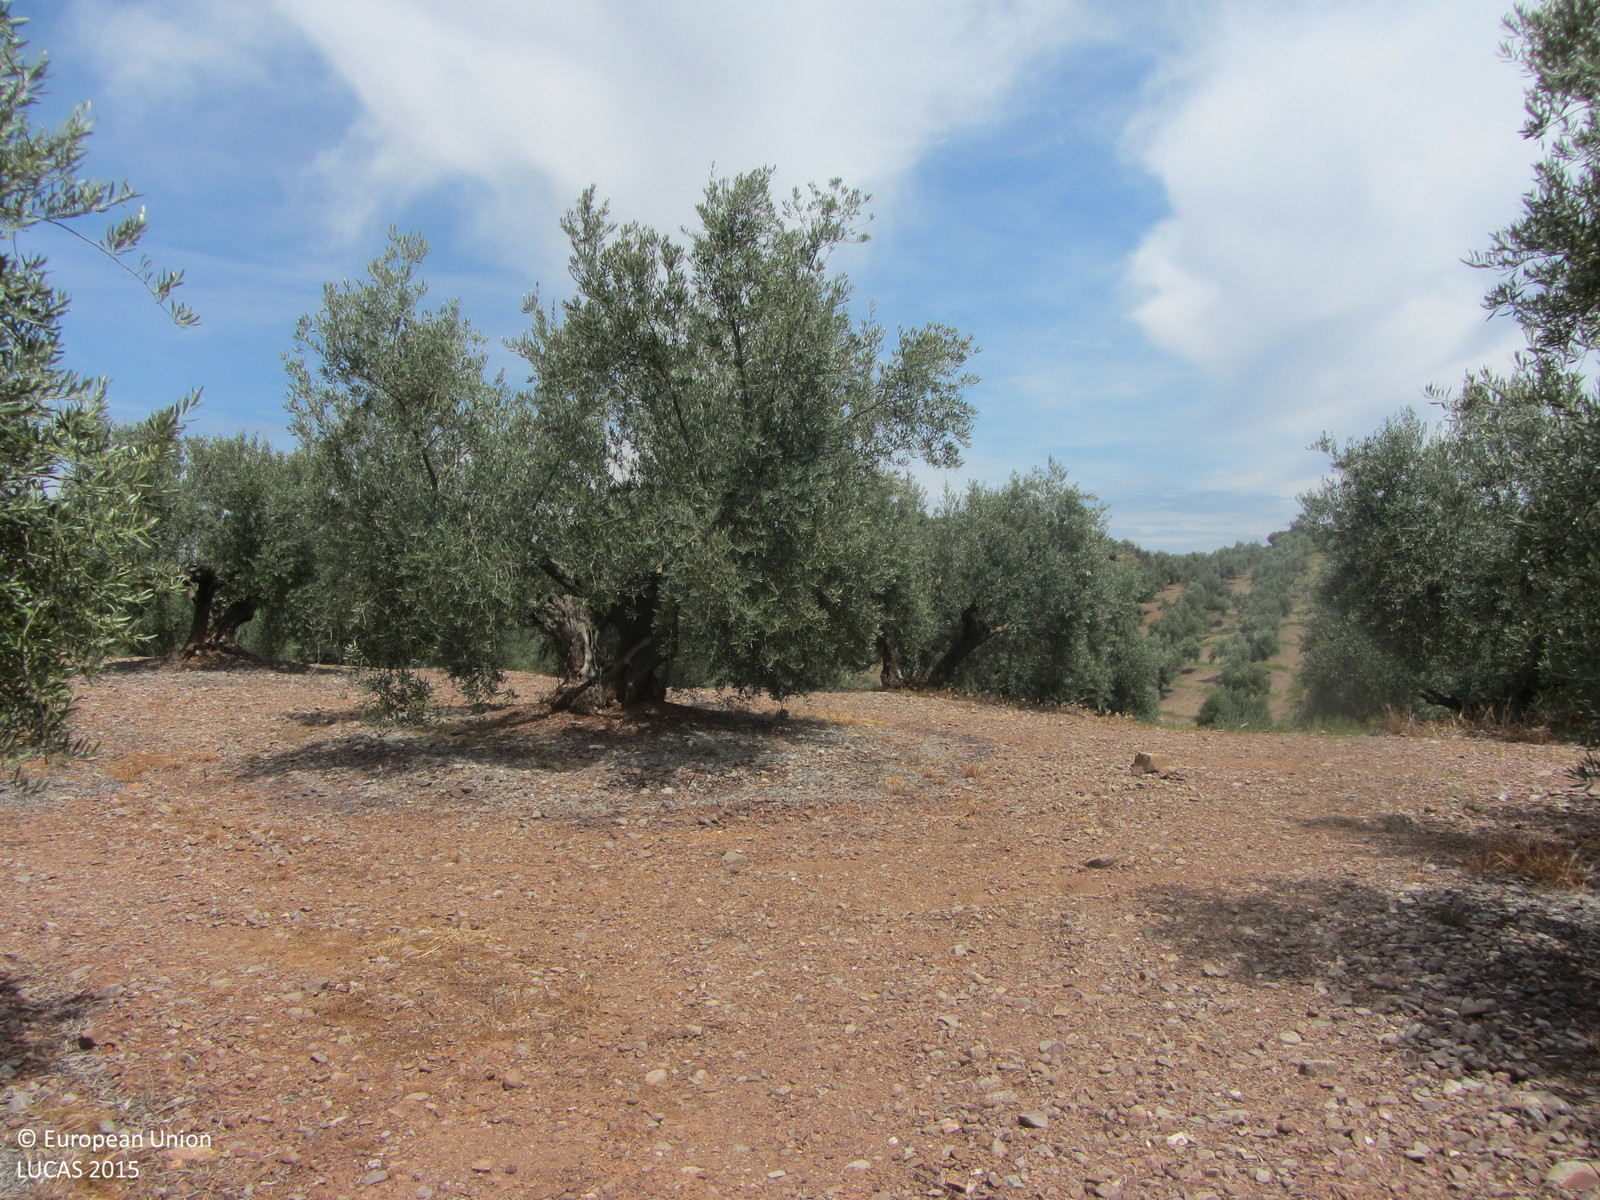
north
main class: Cropland
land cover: Olive groves
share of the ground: 25 - 50 %
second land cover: Other bare soil
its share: > 75 %
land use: Agriculture (excluding fallow land and kitchen gardens)
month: May
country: ES
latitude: 38.3319
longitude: -3.0313
